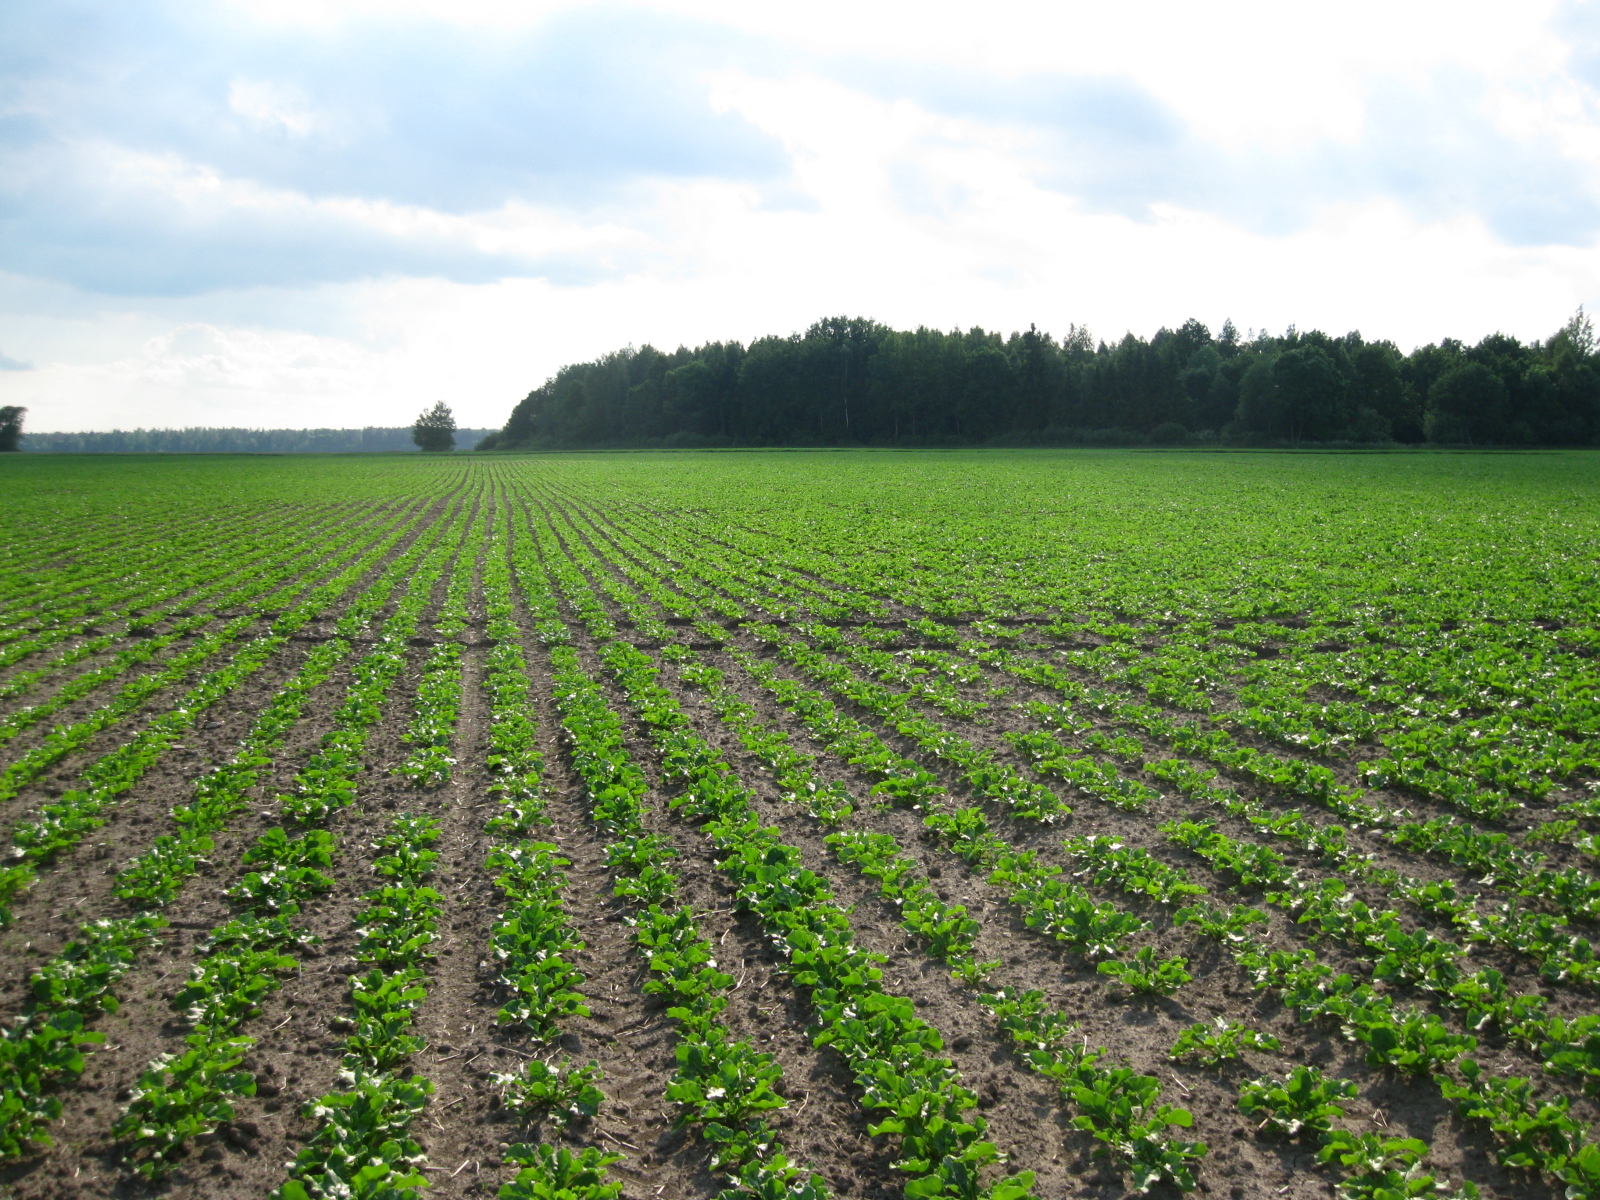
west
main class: Cropland
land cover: Sugar beet
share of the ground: 25 - 50 %
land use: Agriculture (excluding fallow land and kitchen gardens)
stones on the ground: < 10 %
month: June
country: LT
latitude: 55.5616
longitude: 23.8321
